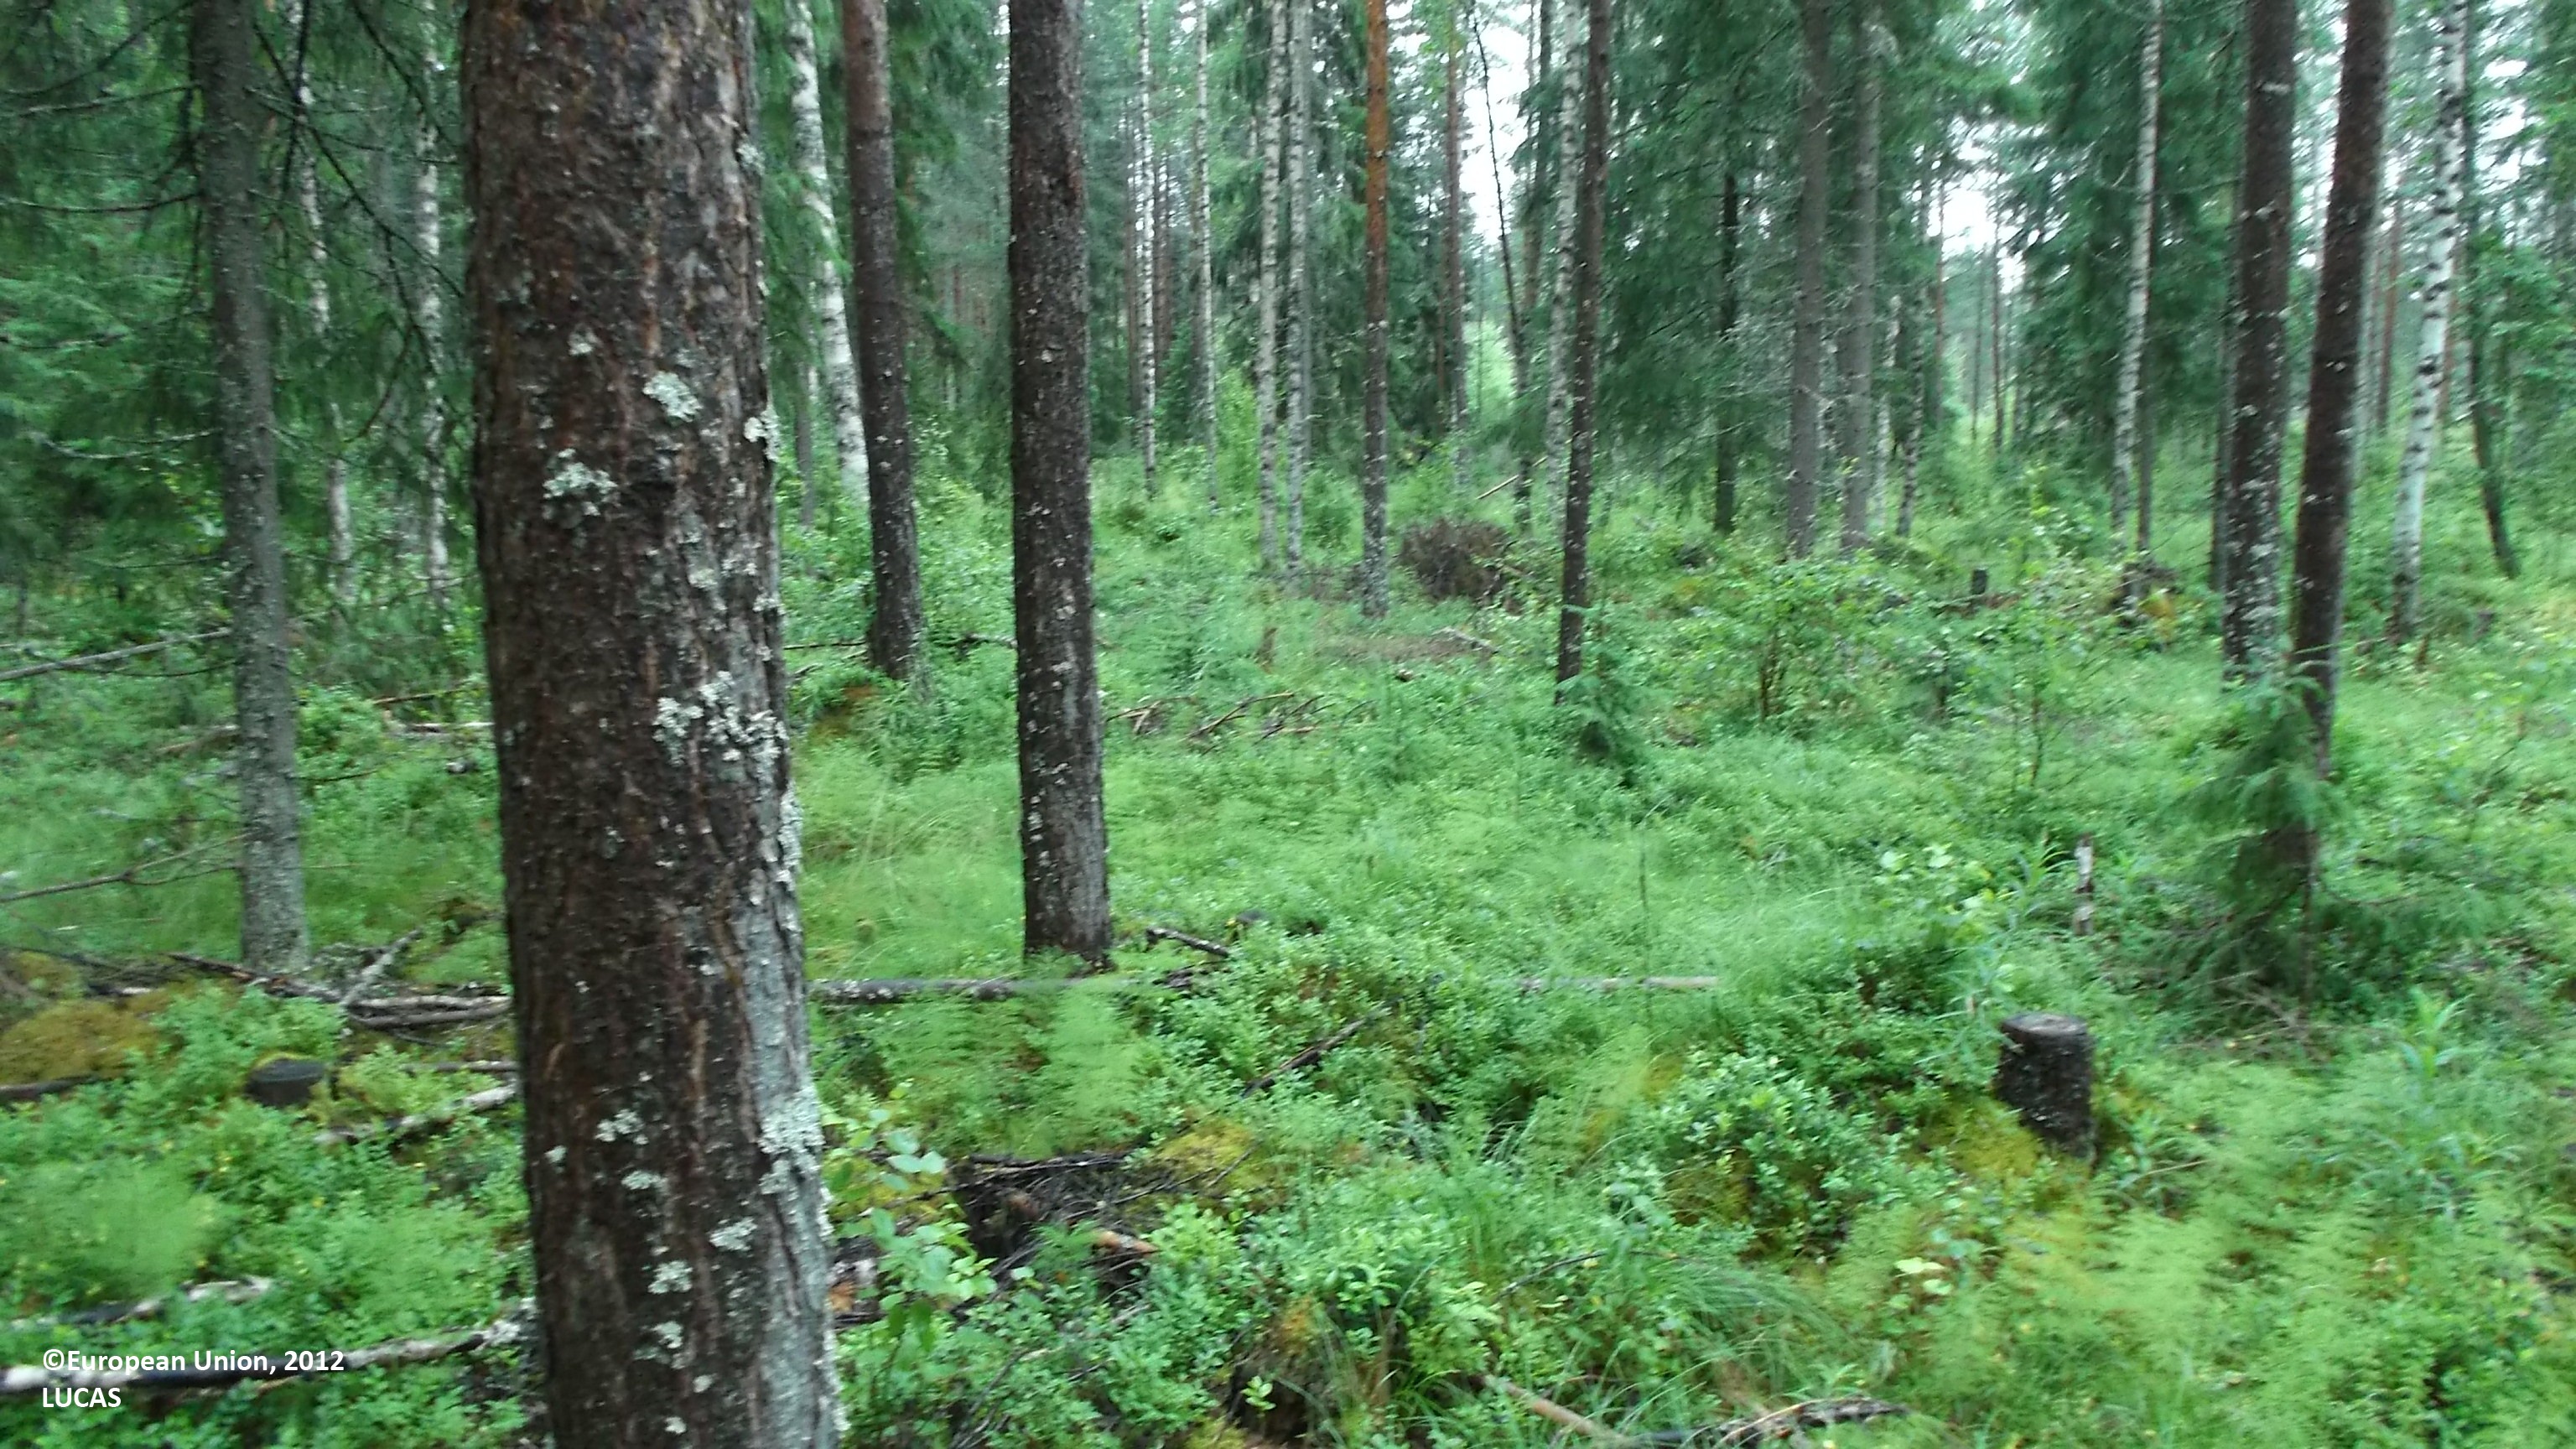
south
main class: Woodland
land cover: Other mixed woodland
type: boreal forest
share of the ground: 50 - 75 %
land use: Forestry
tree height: > 5 m
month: July
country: FI
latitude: 63.4316
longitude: 23.9173
